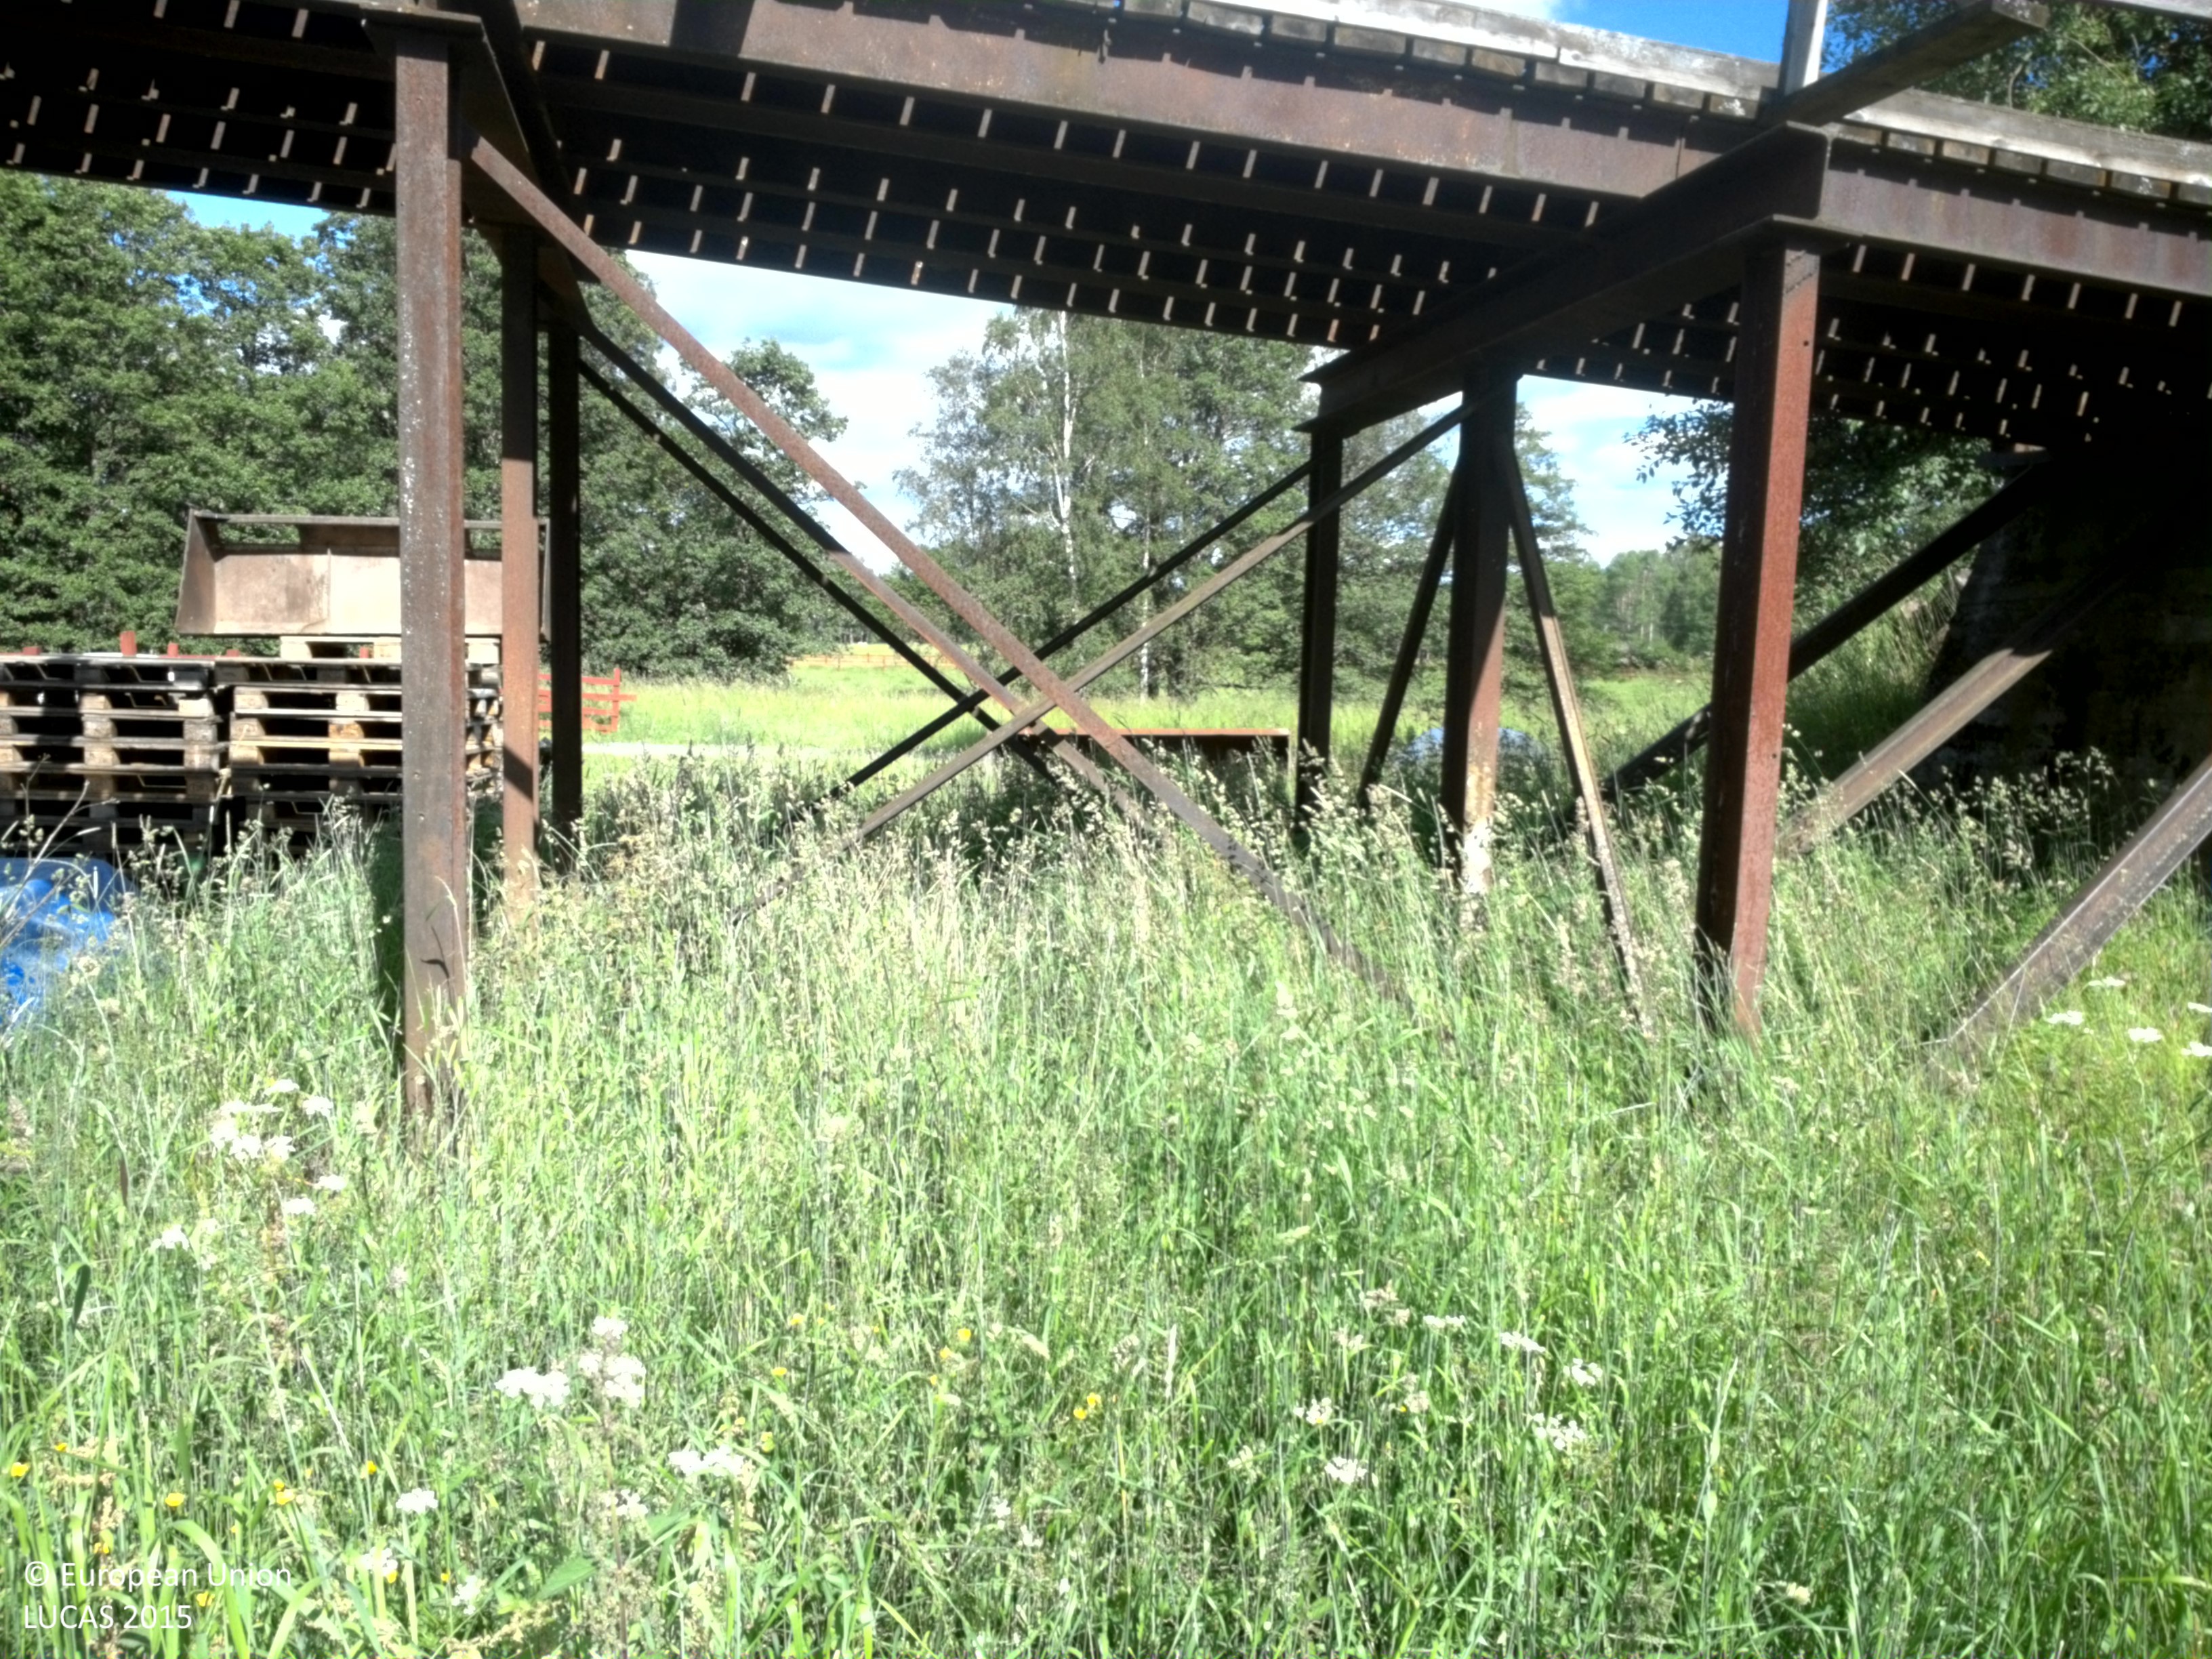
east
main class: Grassland
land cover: Grassland with sparse tree/shrub cover
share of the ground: > 75 %
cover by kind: herbaceous plants 95 %, coniferous forest trees 5 %
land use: Agriculture (excluding fallow land and kitchen gardens)
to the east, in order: Grassland with sparse tree/shrub cover; Artificial constructions in urban areas; Grassland with sparse tree/shrub cover; Broadleaved woodland; Inland fresh running water; Grassland with sparse tree/shrub cover; Fences; Ditches and canals; Grass margins; Paved roads, cycling and walking lanes; Grass margins; Ditches and canals; Fences; Grassland with sparse tree/shrub cover
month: July
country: SE
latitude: 59.9582
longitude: 16.8860
